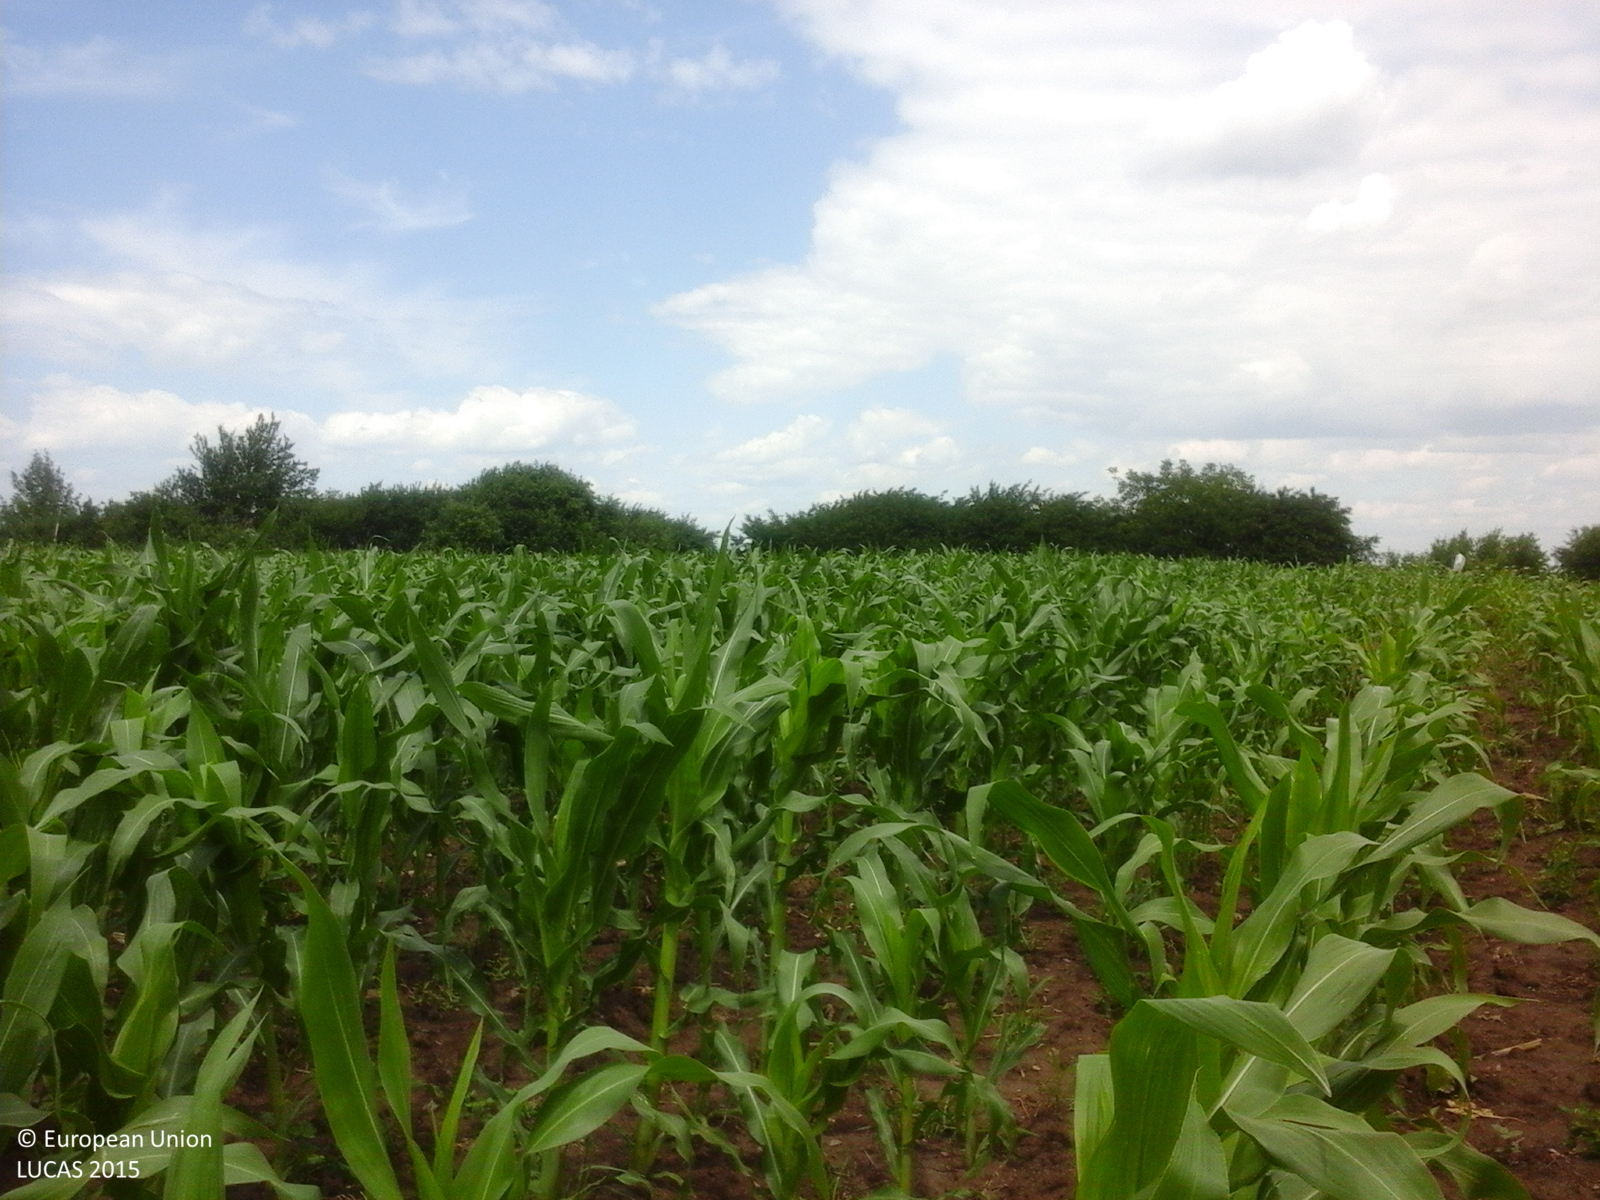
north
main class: Cropland
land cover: Maize
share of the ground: 50 - 75 %
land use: Agriculture (excluding fallow land and kitchen gardens)
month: June
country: RO
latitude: 47.8114
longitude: 26.3934
